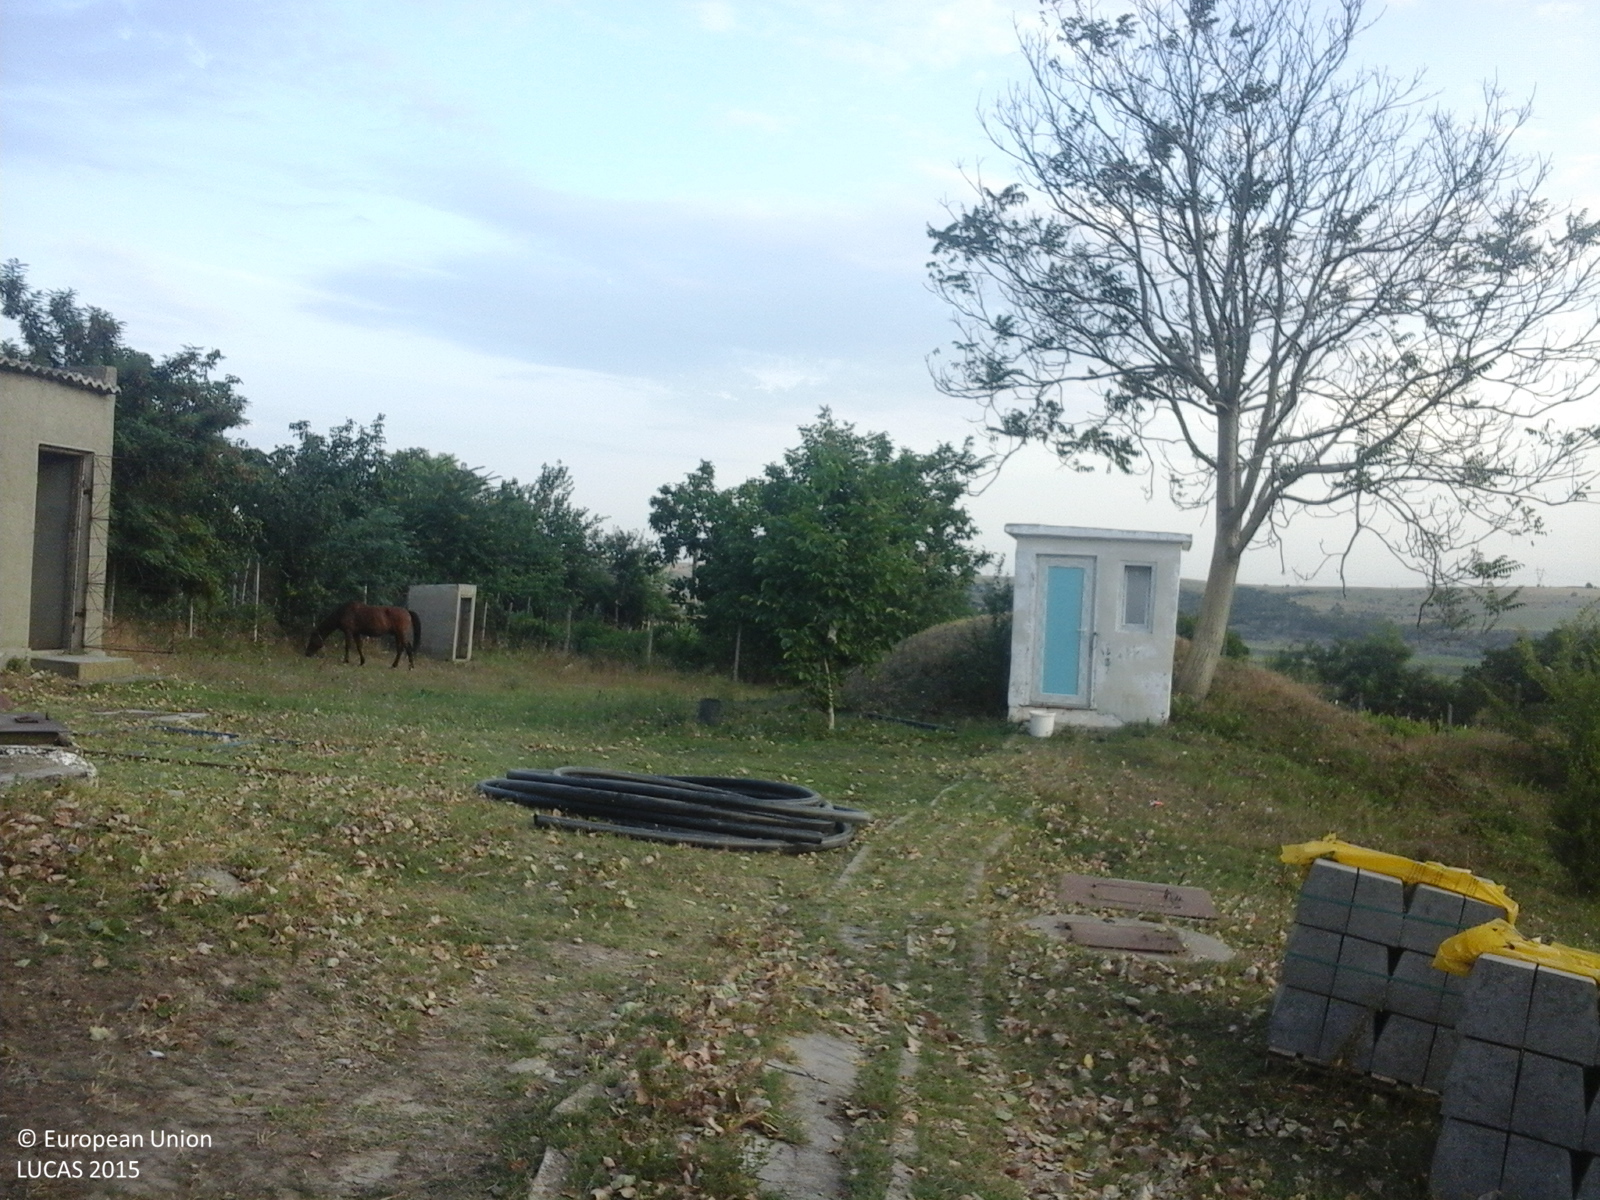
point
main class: Grassland
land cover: Grassland with sparse tree/shrub cover
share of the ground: > 75 %
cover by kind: herbaceous plants 85 %, shrubs 10 %, broadleaved forest trees 5 %
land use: Community services
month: August
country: RO
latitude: 44.3719
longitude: 28.0666
